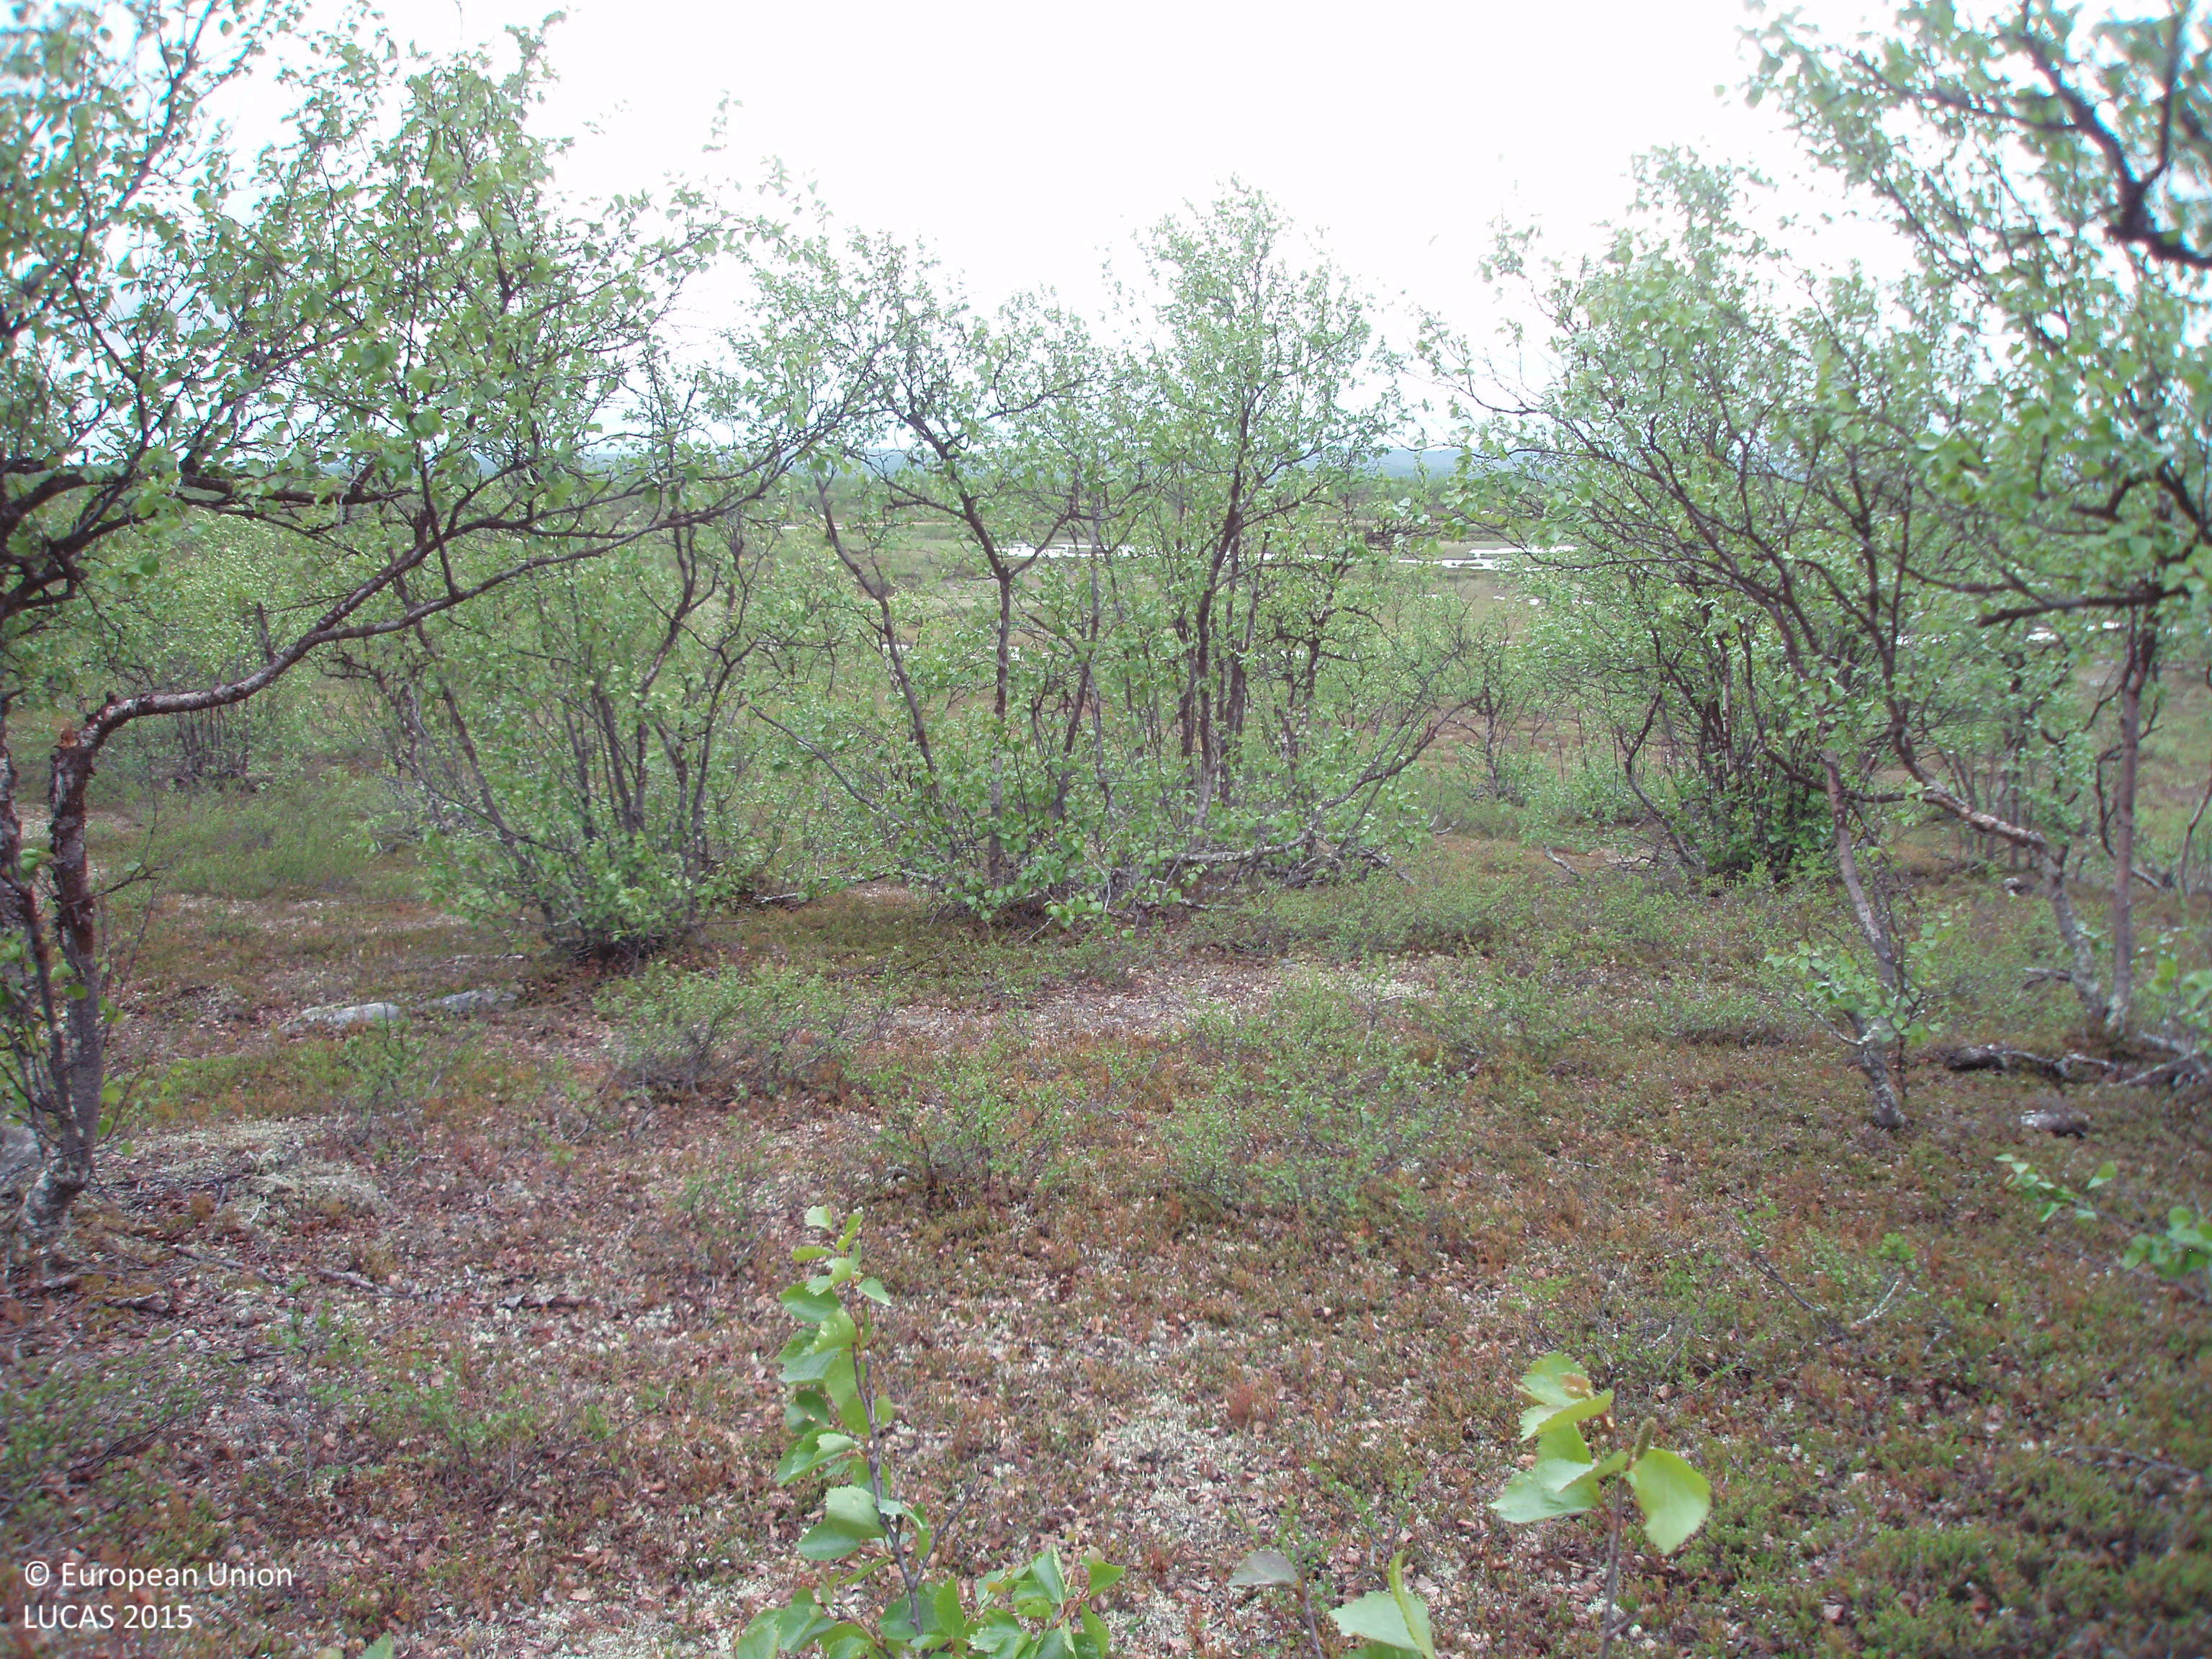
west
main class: Woodland
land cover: Broadleaved woodland
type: boreal forest
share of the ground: 50 - 75 %
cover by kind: broadleaved forest trees 60 %, shrubs 35 %, lichens and mosses 5 %
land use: Semi-natural and natural areas not in use
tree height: > 5 m
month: July
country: FI
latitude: 69.4700
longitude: 27.2504
